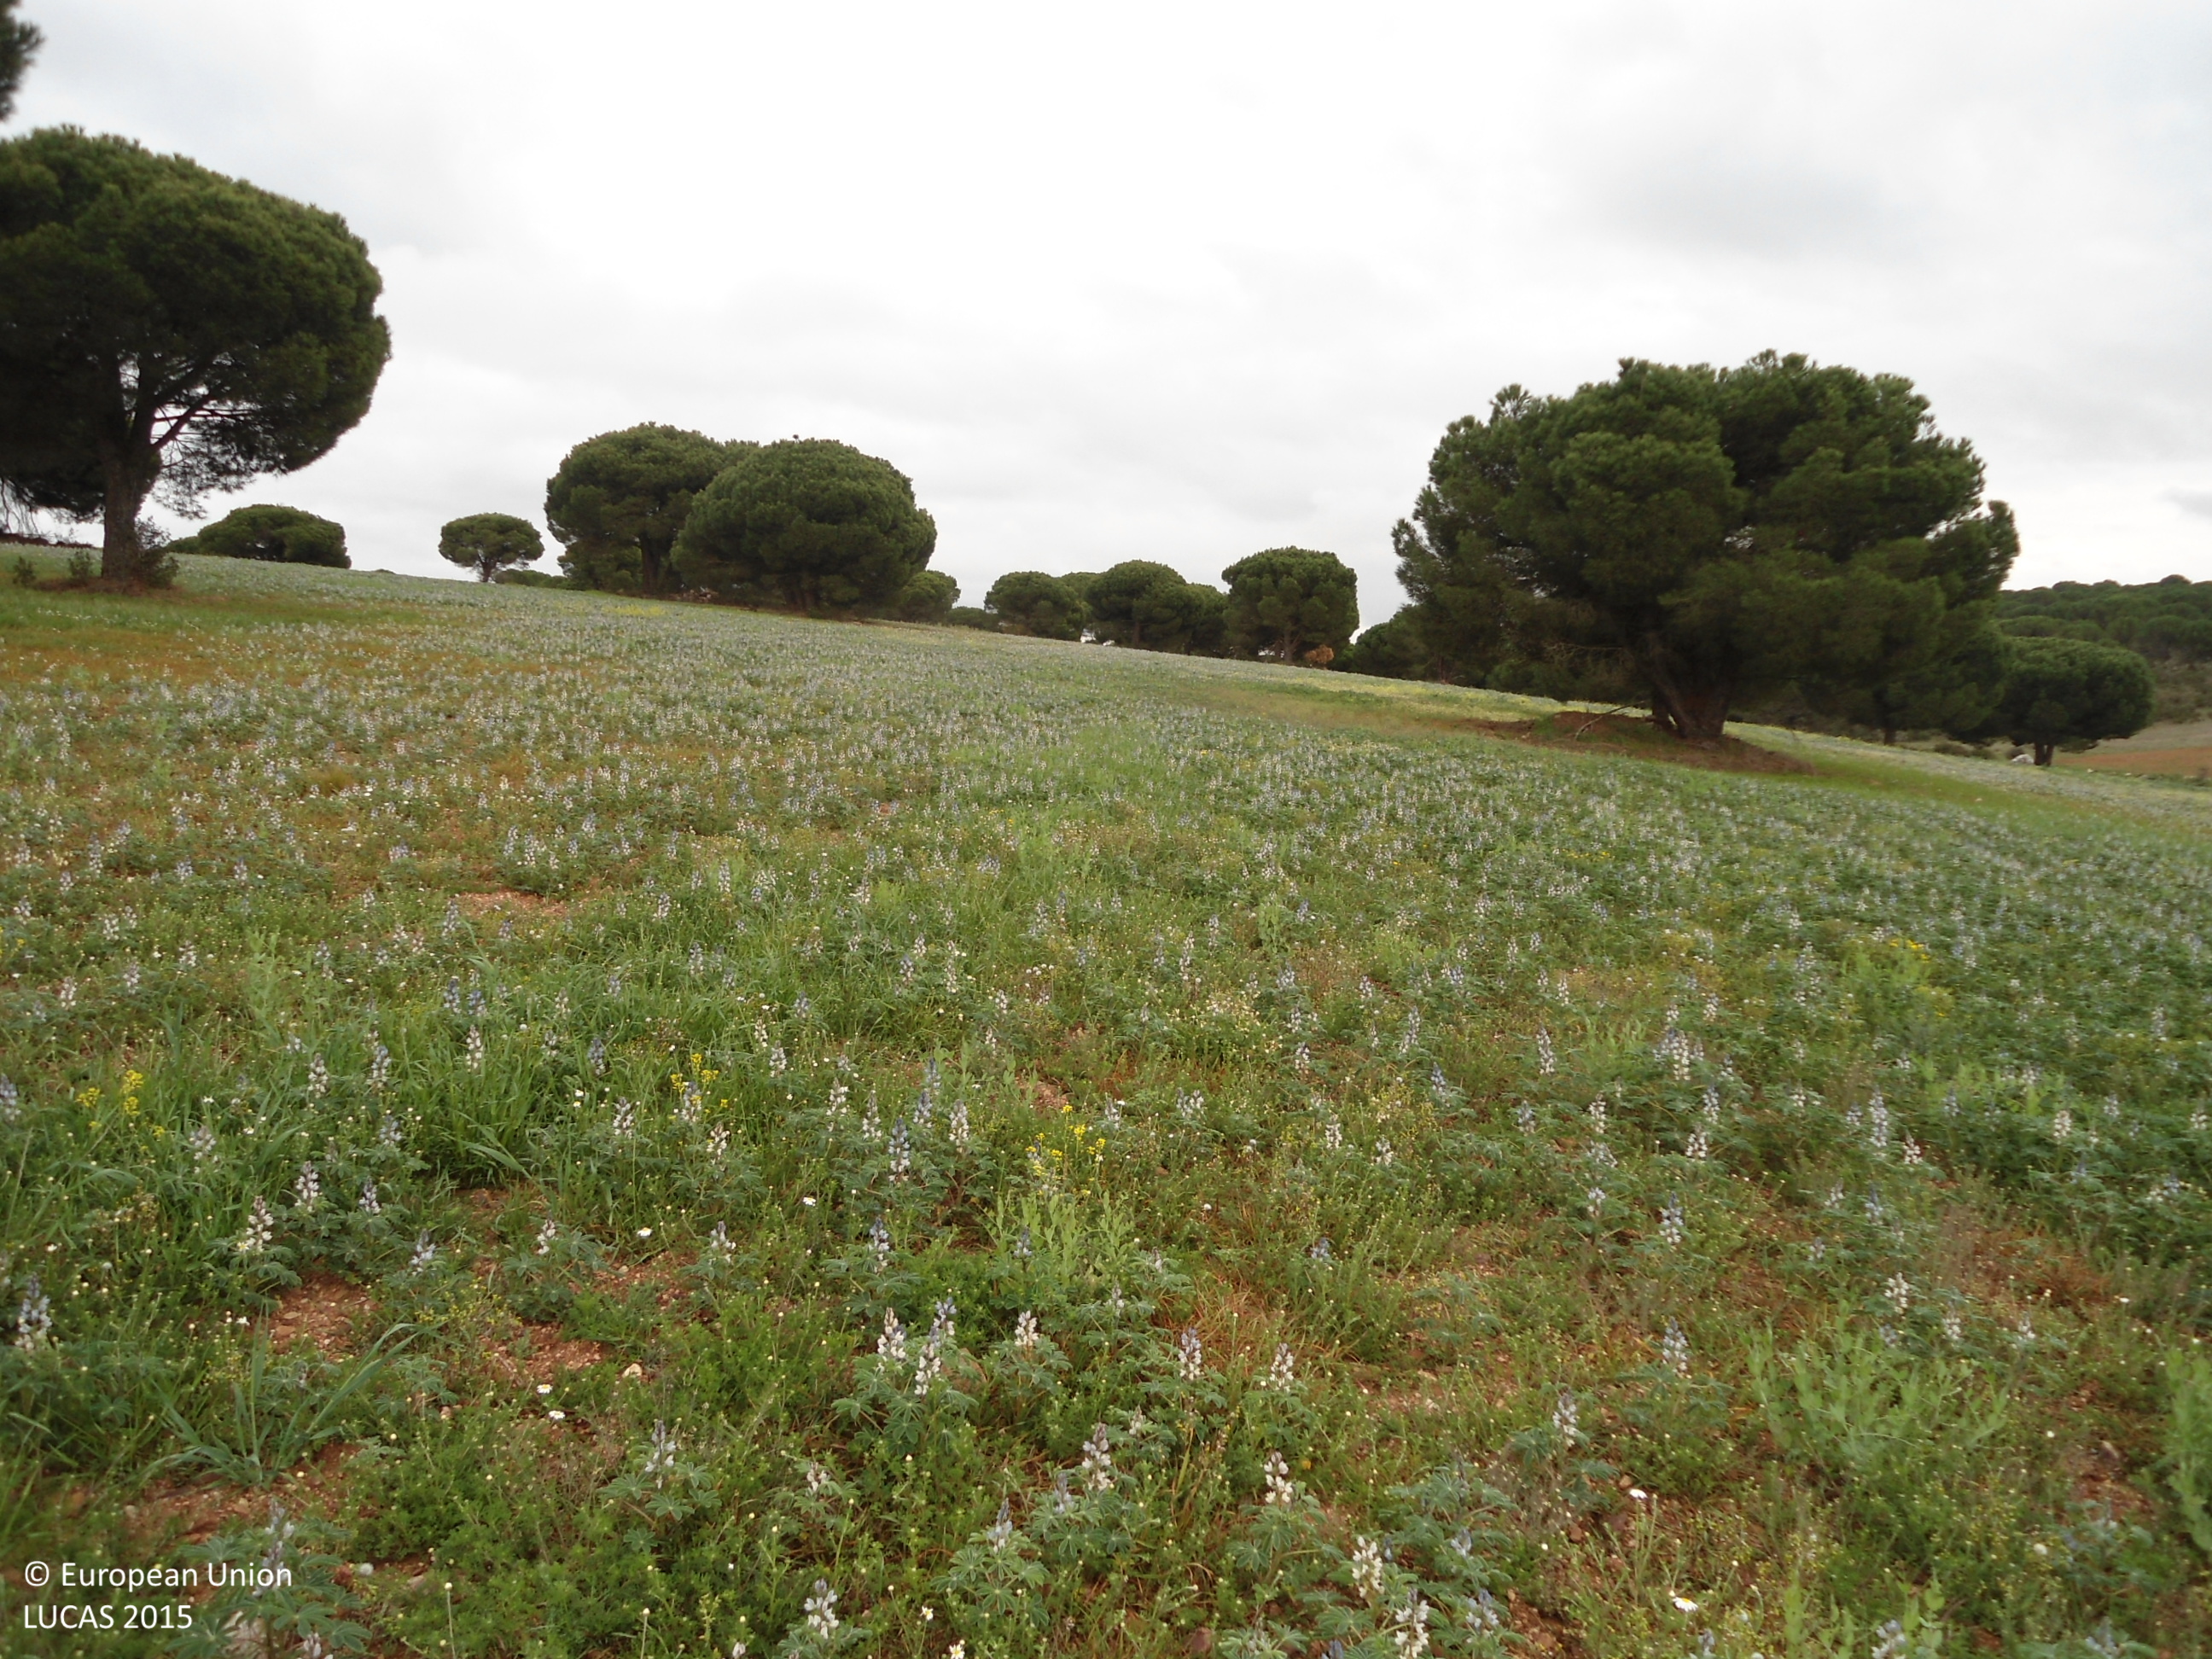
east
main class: Cropland
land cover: Dry pulses
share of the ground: > 75 %
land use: Agriculture (excluding fallow land and kitchen gardens)
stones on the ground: 10 - 25 %
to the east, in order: Dry pulses; Single bushes/trees; Dry pulses; Spontaneously vegetated surfaces; Pine dominated coniferous woodland; Shrubland with sparse tree cover; Fences; Pine dominated coniferous woodland
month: April
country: ES
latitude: 41.5609
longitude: -5.8573
